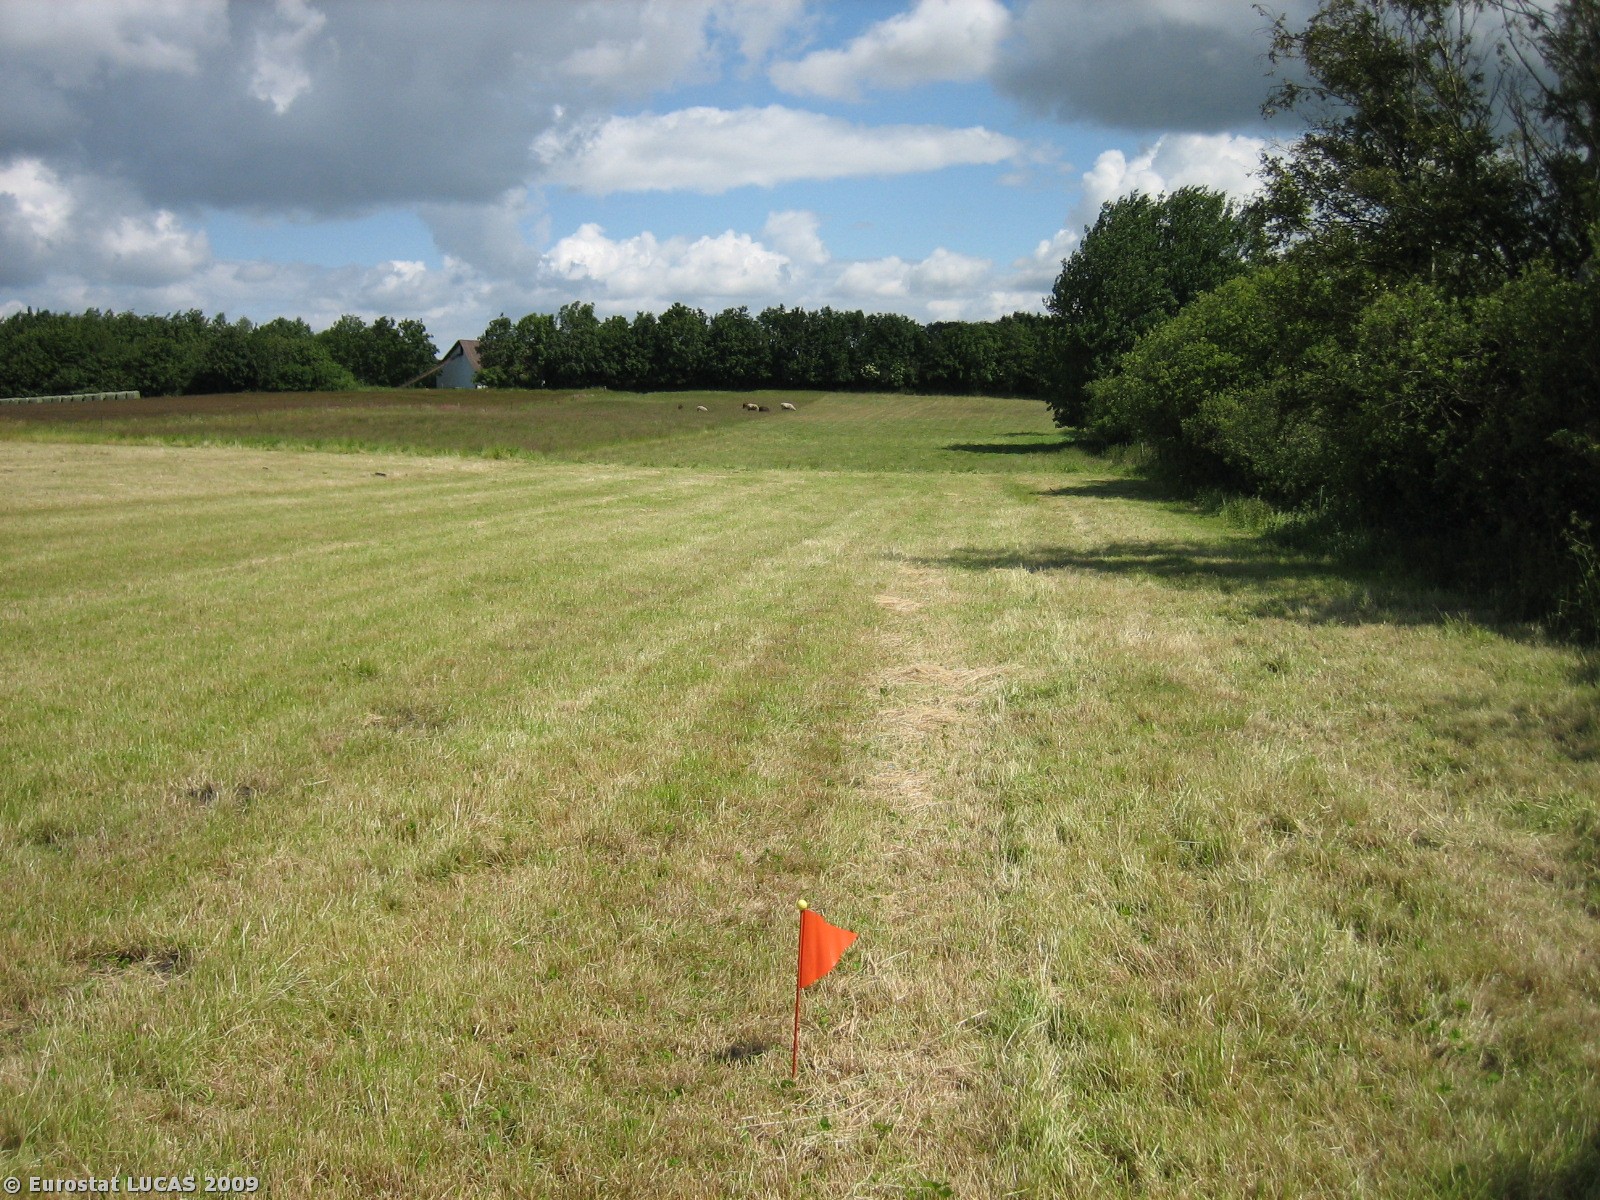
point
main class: Cropland
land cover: Temporary grasslands
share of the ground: > 75 %
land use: Agriculture (excluding fallow land and kitchen gardens)
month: June
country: DK
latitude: 55.5927
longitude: 9.3183
